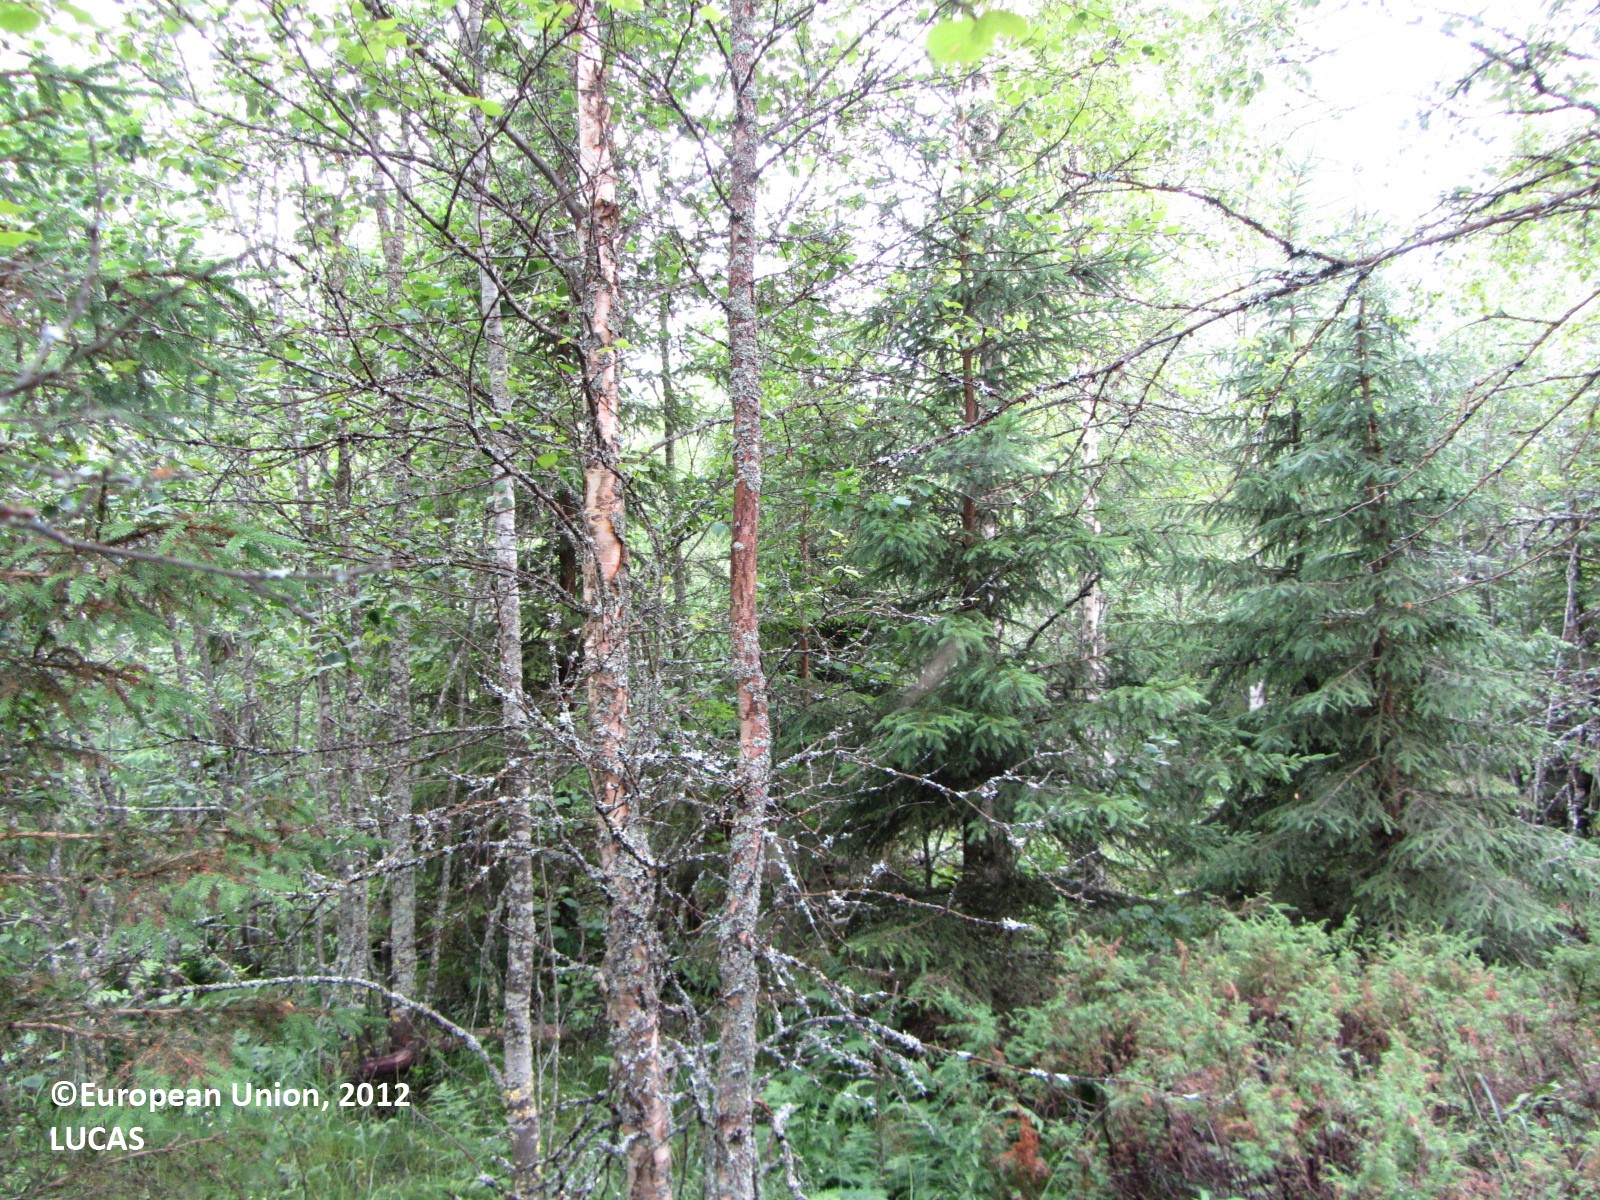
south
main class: Woodland
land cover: Spruce dominated mixed woodland
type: boreal forest
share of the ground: 50 - 75 %
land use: Forestry
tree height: > 5 m
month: July
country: FI
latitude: 63.8442
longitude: 25.5725
